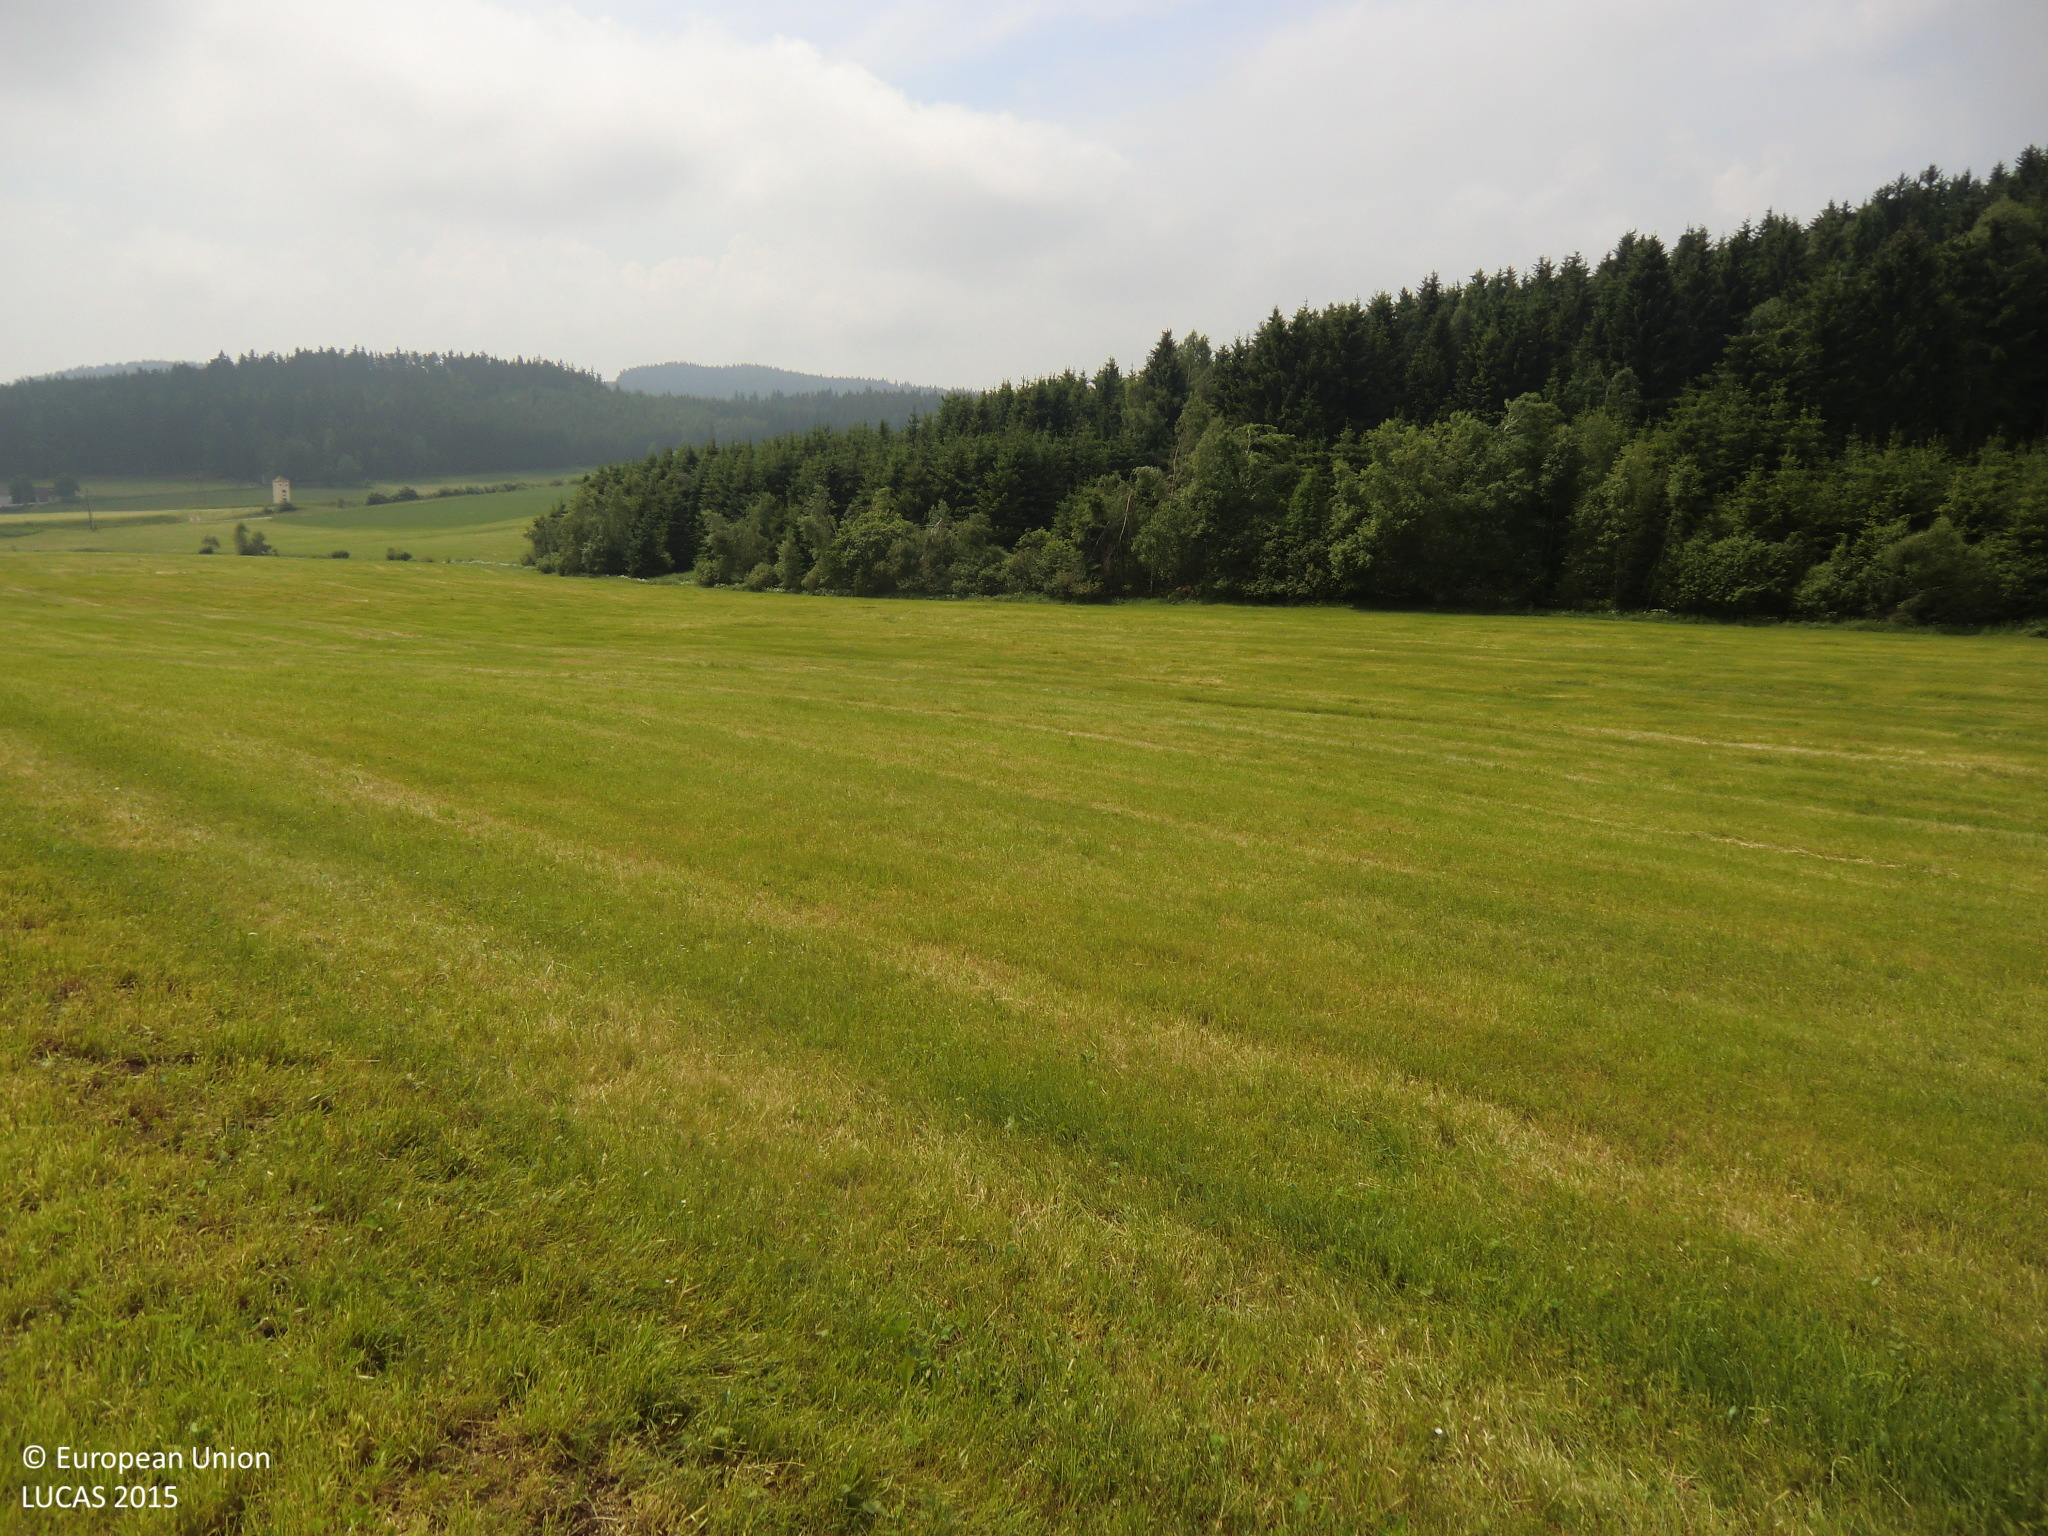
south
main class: Cropland
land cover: Temporary grasslands
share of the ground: > 75 %
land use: Agriculture (excluding fallow land and kitchen gardens)
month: June
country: AT
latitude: 48.5871
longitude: 14.8140
